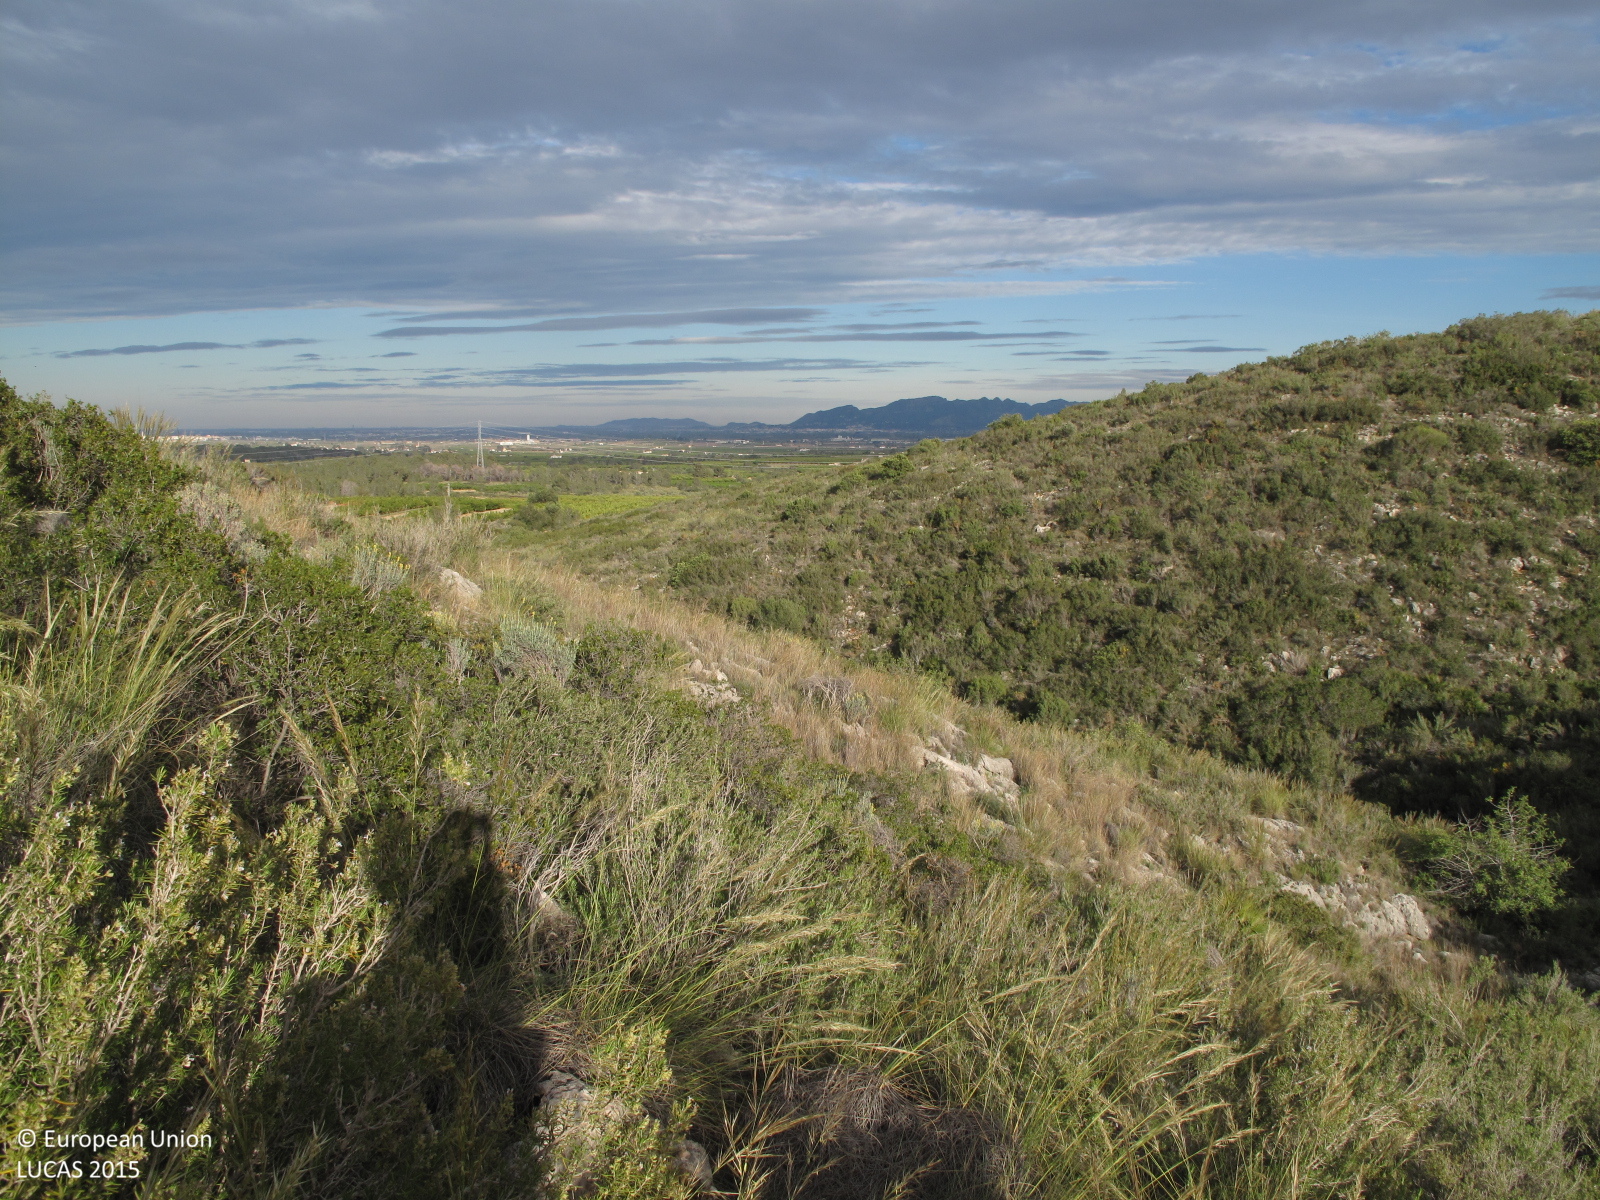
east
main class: Shrubland
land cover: Shrubland without tree cover
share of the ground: > 75 %
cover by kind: shrubs 70 %, herbaceous plants 20 %, unconsolidated bare surface 10 %
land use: Semi-natural and natural areas not in use
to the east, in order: Shrubland without tree cover; Grassland without tree/shrub cover; Shrubland without tree cover; Rivers and streams; Shrubland without tree cover
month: March
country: ES
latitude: 39.1616
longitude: -0.6075
